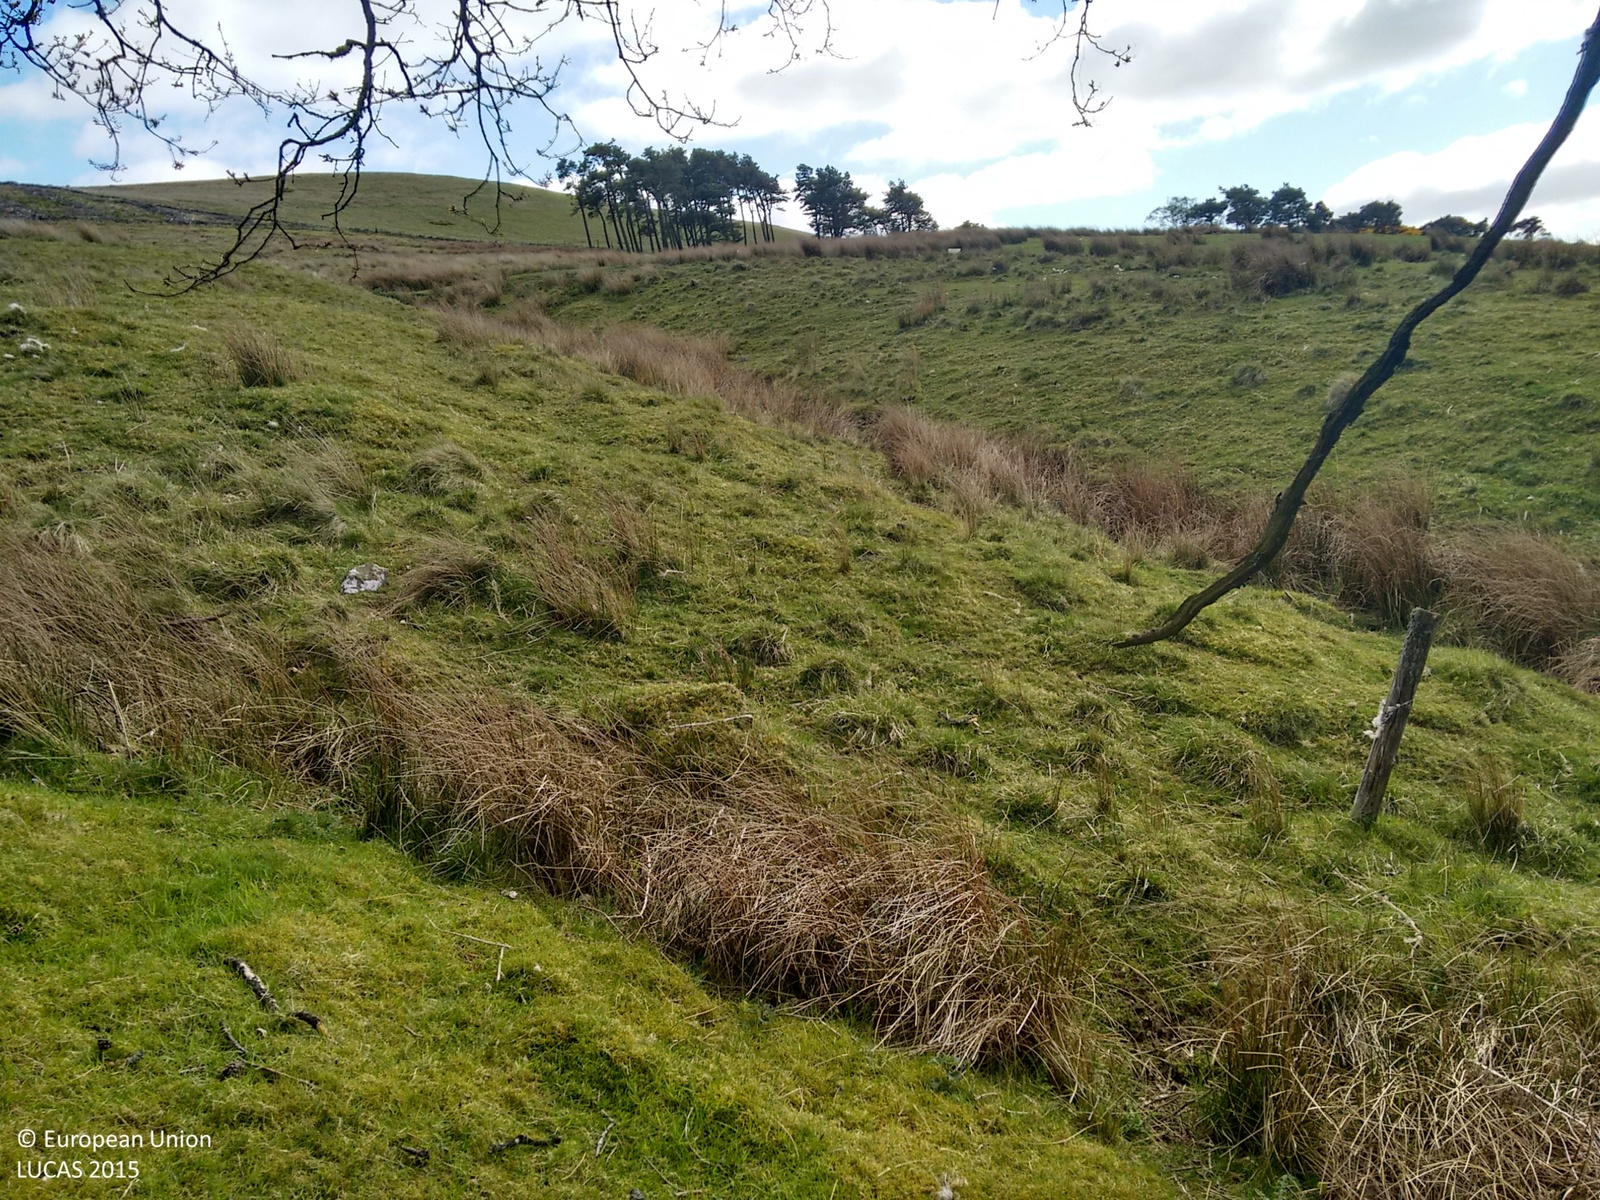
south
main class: Woodland
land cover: Pine dominated mixed woodland
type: hemiboreal forest and nemoral coniferous forest and mixed broadleaved-coniferous forest
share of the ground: > 75 %
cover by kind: coniferous forest trees 70 %, broadleaved forest trees 25 %, herbaceous plants 5 %
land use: Agriculture (excluding fallow land and kitchen gardens)
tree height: > 5 m
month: May
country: GB
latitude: 55.7279
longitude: -3.3064
